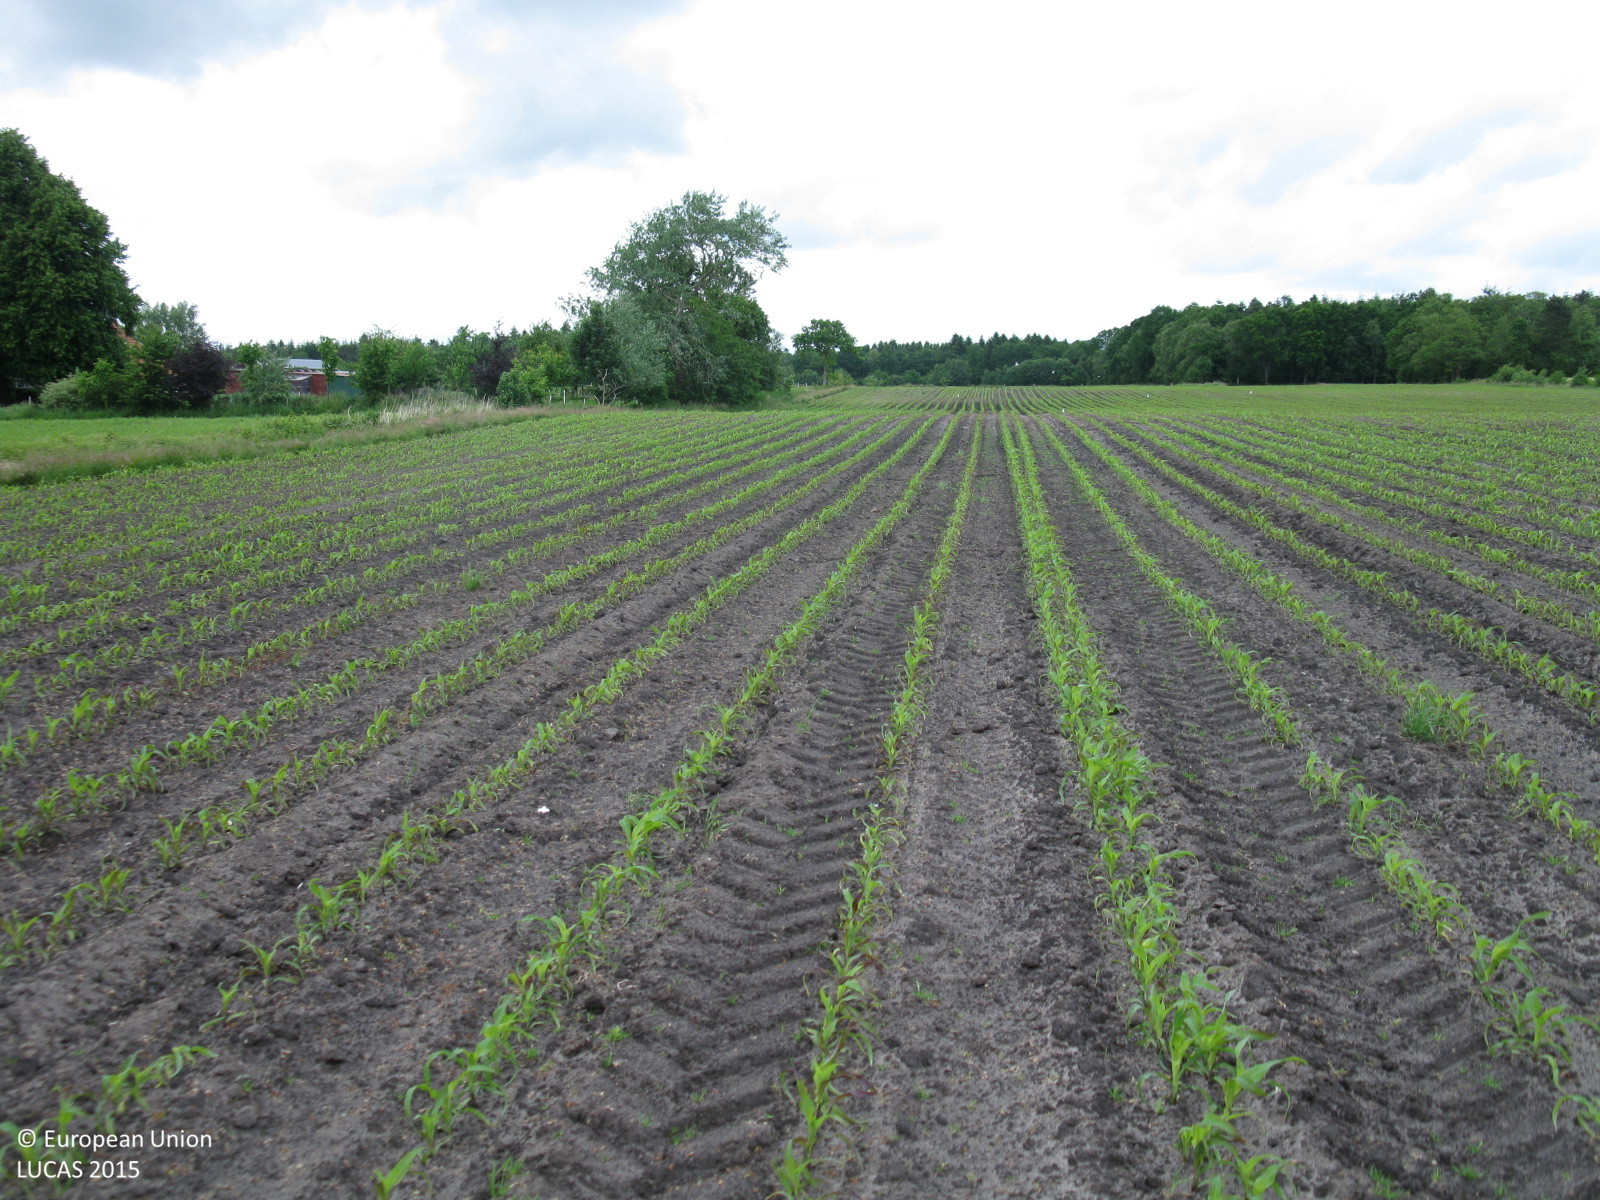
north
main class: Cropland
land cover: Maize
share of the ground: 10 - 25 %
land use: Agriculture (excluding fallow land and kitchen gardens)
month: June
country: DE
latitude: 53.5703
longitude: 7.3279
